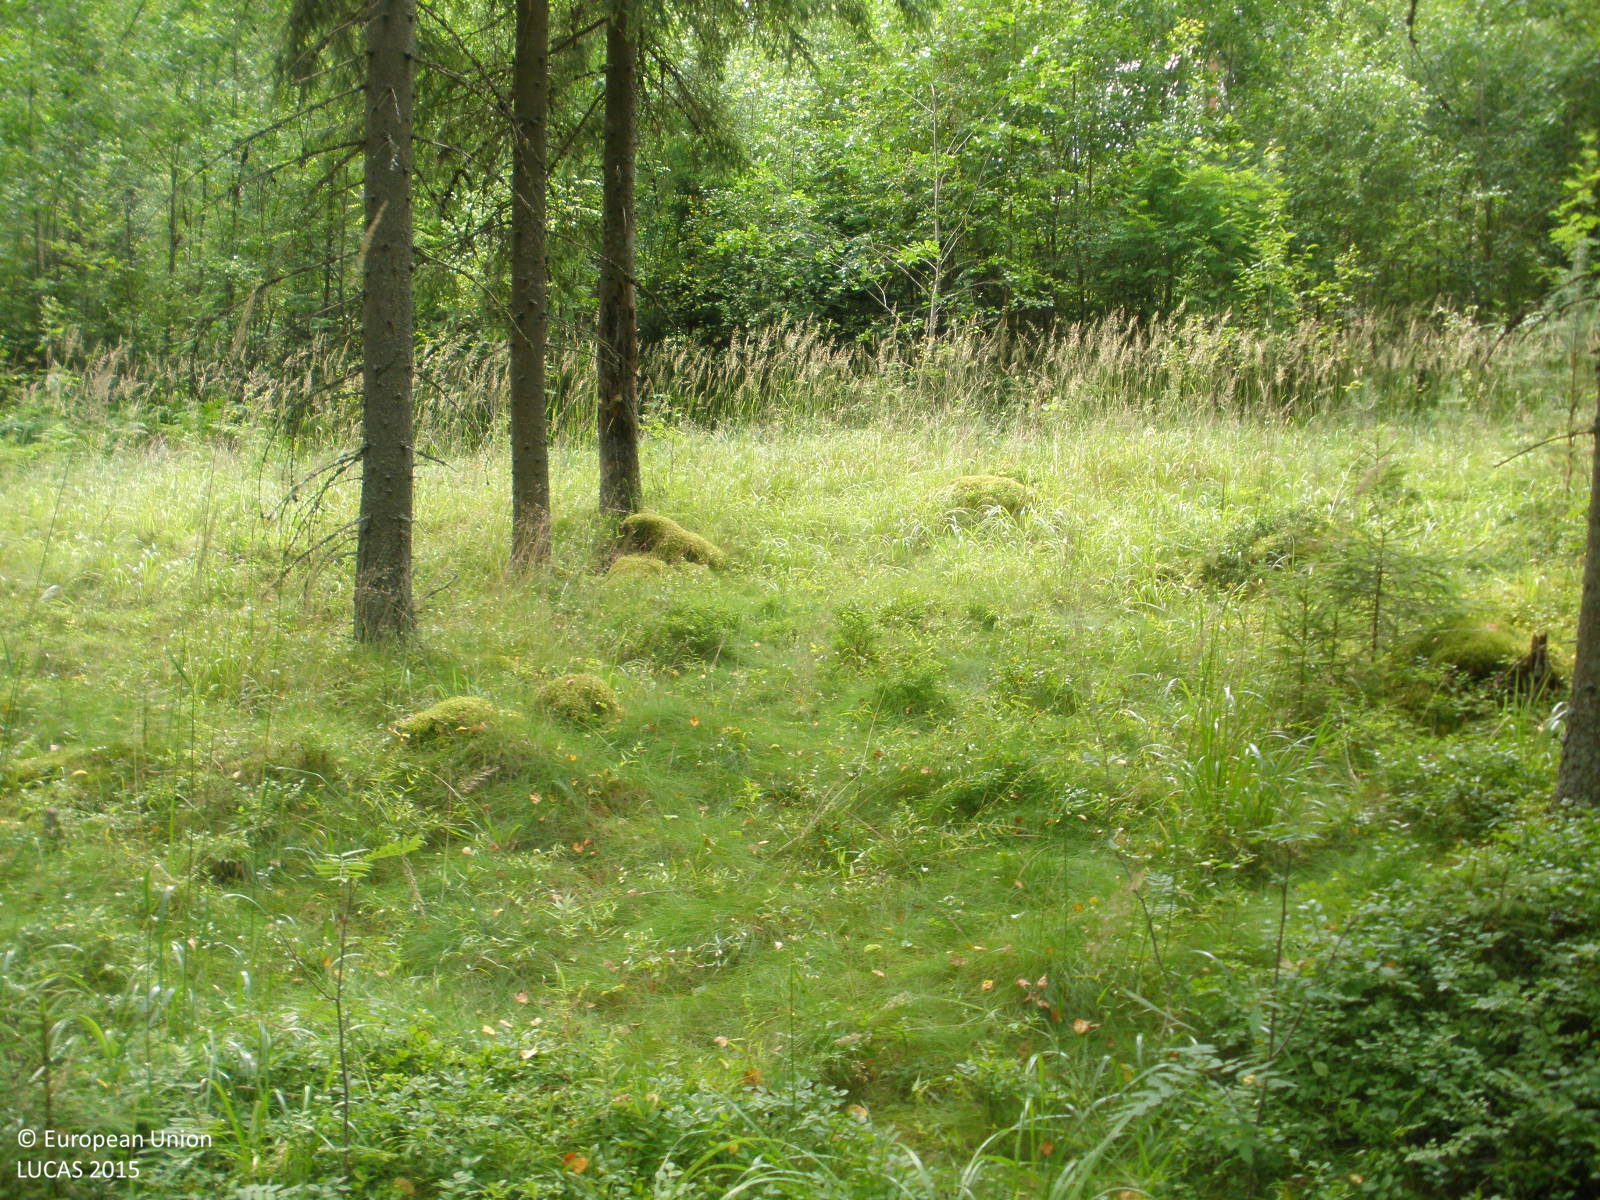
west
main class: Woodland
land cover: Spruce dominated coniferous woodland
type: boreal forest
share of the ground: > 75 %
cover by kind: coniferous forest trees 80 %, herbaceous plants 10 %, broadleaved forest trees 5 %, lichens and mosses 5 %
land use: Forestry
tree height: > 5 m
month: August
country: FI
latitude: 60.7365
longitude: 24.4259
